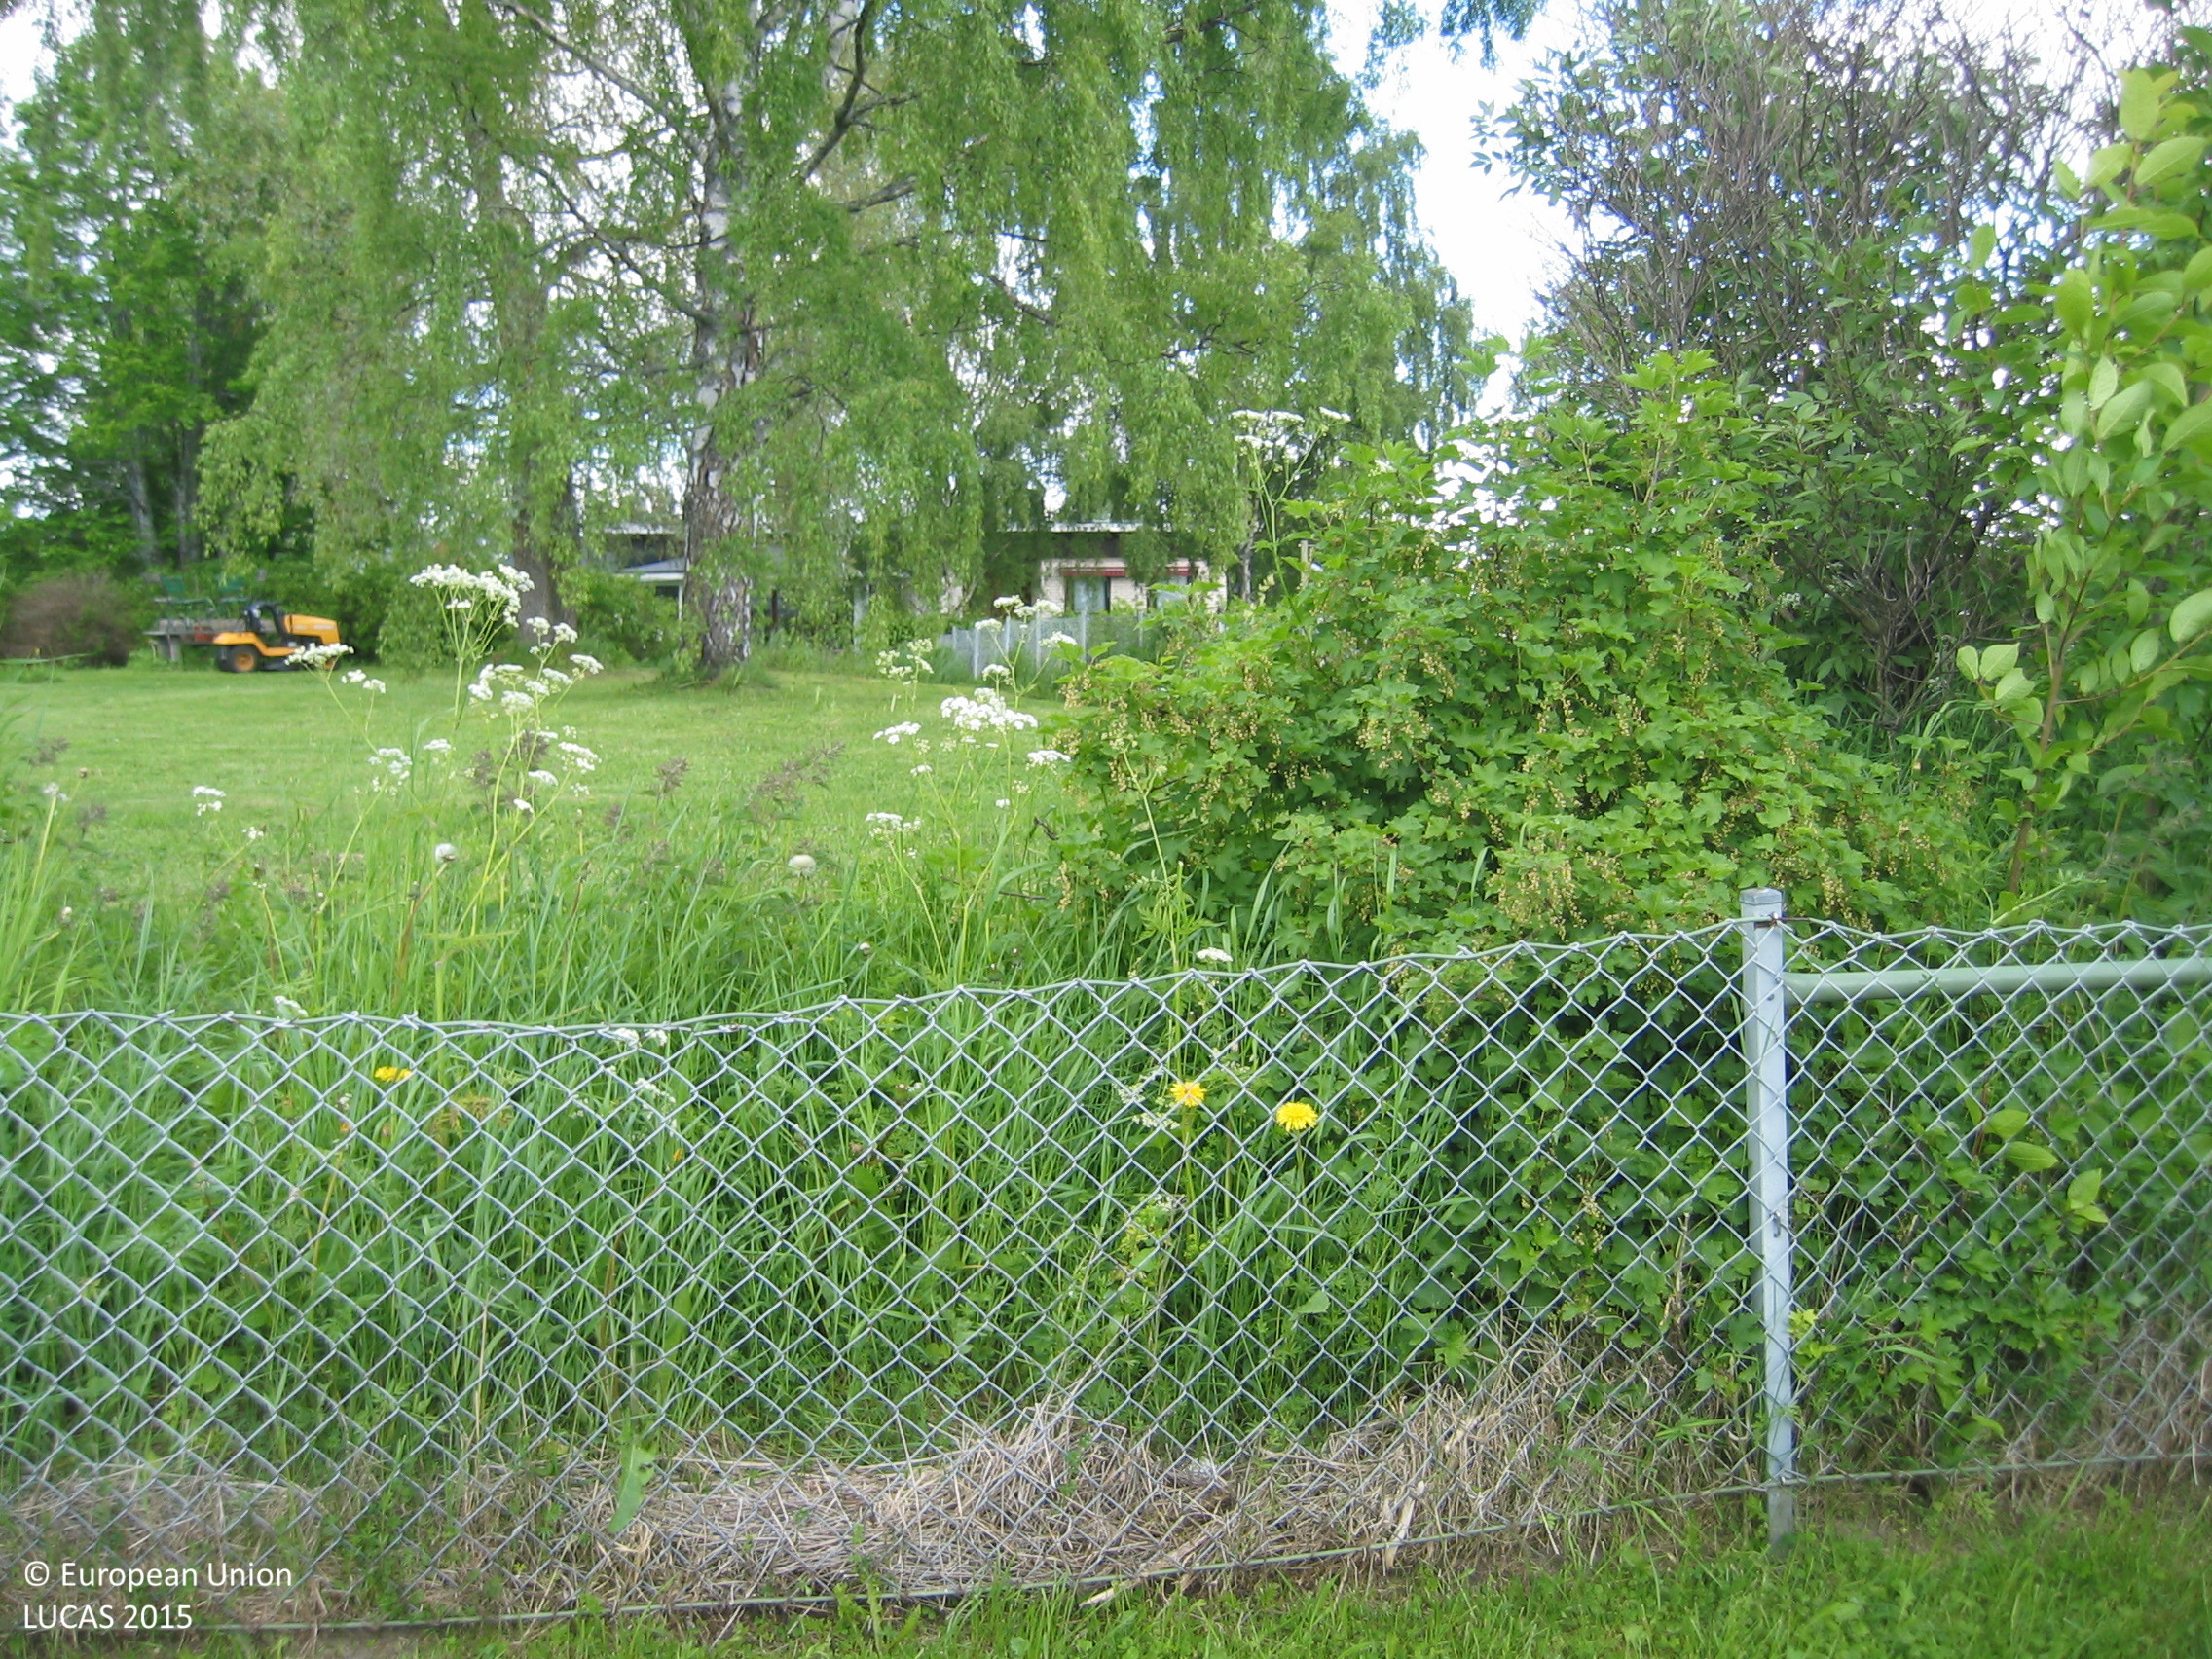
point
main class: Grassland
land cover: Grassland with sparse tree/shrub cover
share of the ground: > 75 %
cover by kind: herbaceous plants 95 %, broadleaved forest trees 5 %
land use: Residential
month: June
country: SE
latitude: 63.5840
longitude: 15.3543
